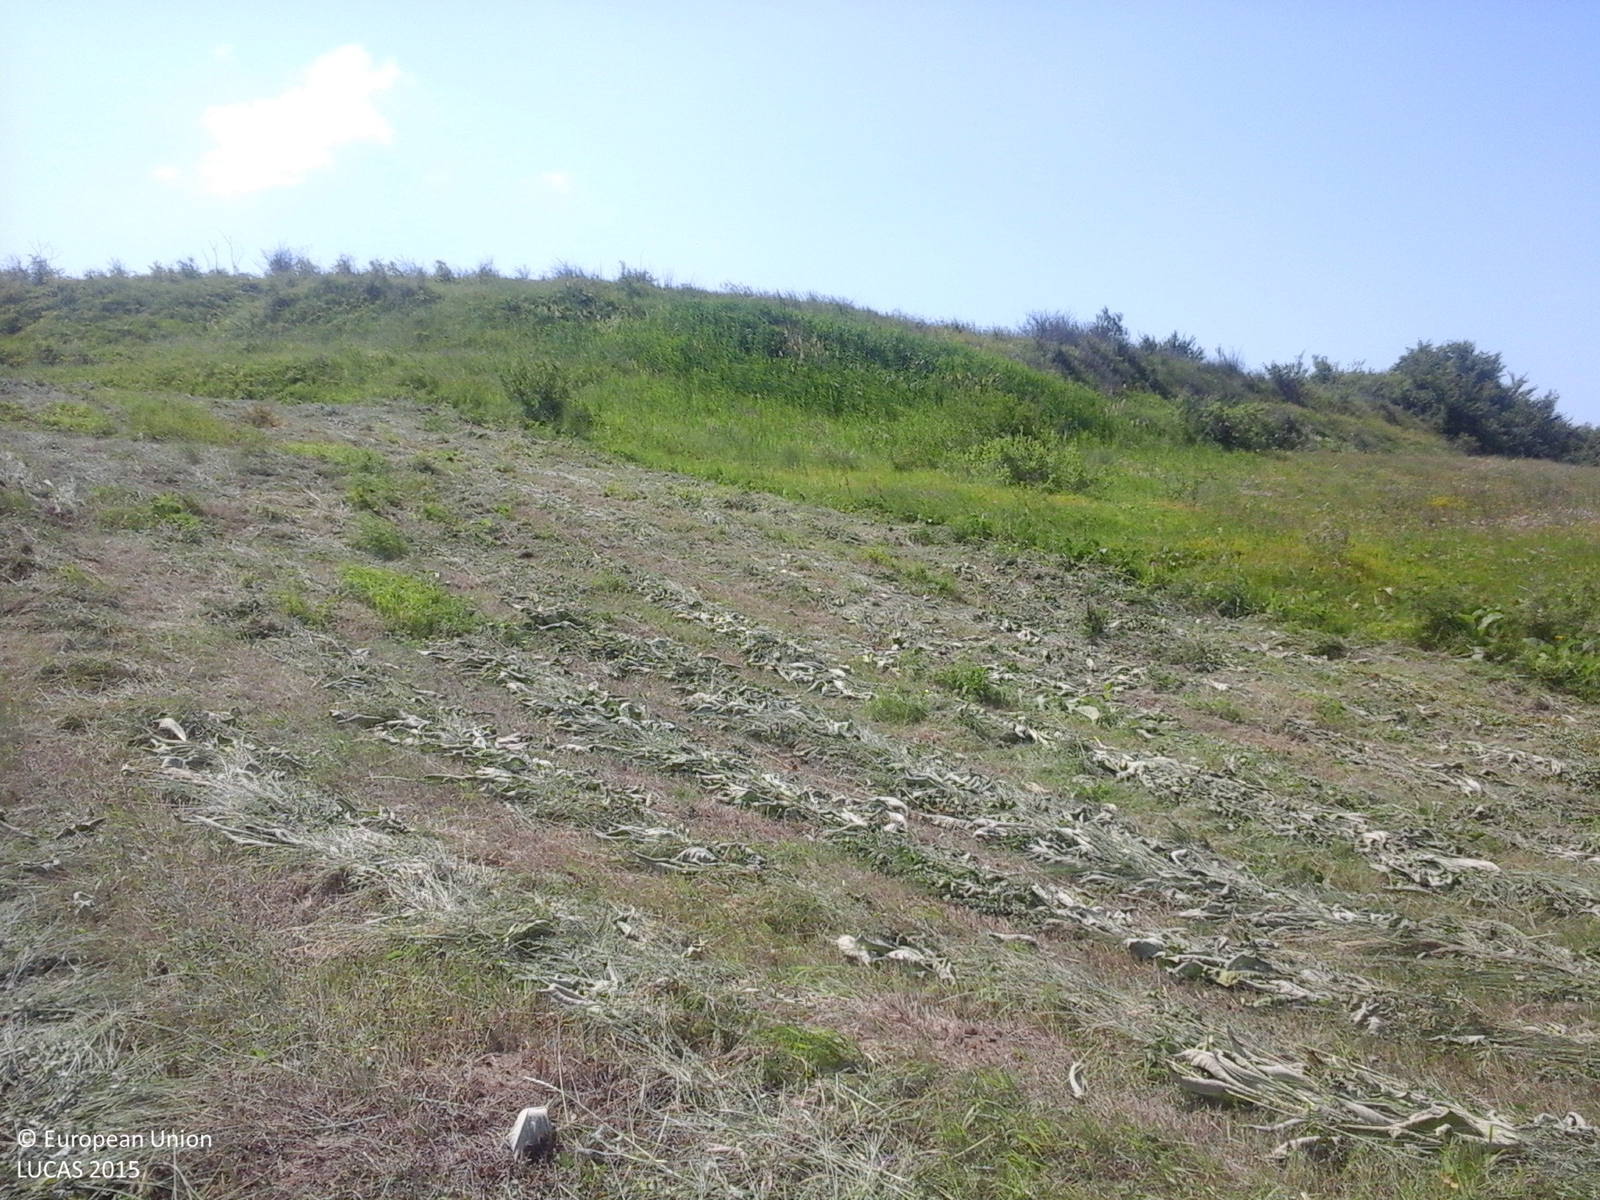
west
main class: Grassland
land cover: Grassland without tree/shrub cover
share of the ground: > 75 %
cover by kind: herbaceous plants 100 %
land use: Agriculture (excluding fallow land and kitchen gardens)
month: June
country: RO
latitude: 46.8936
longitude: 27.2070
